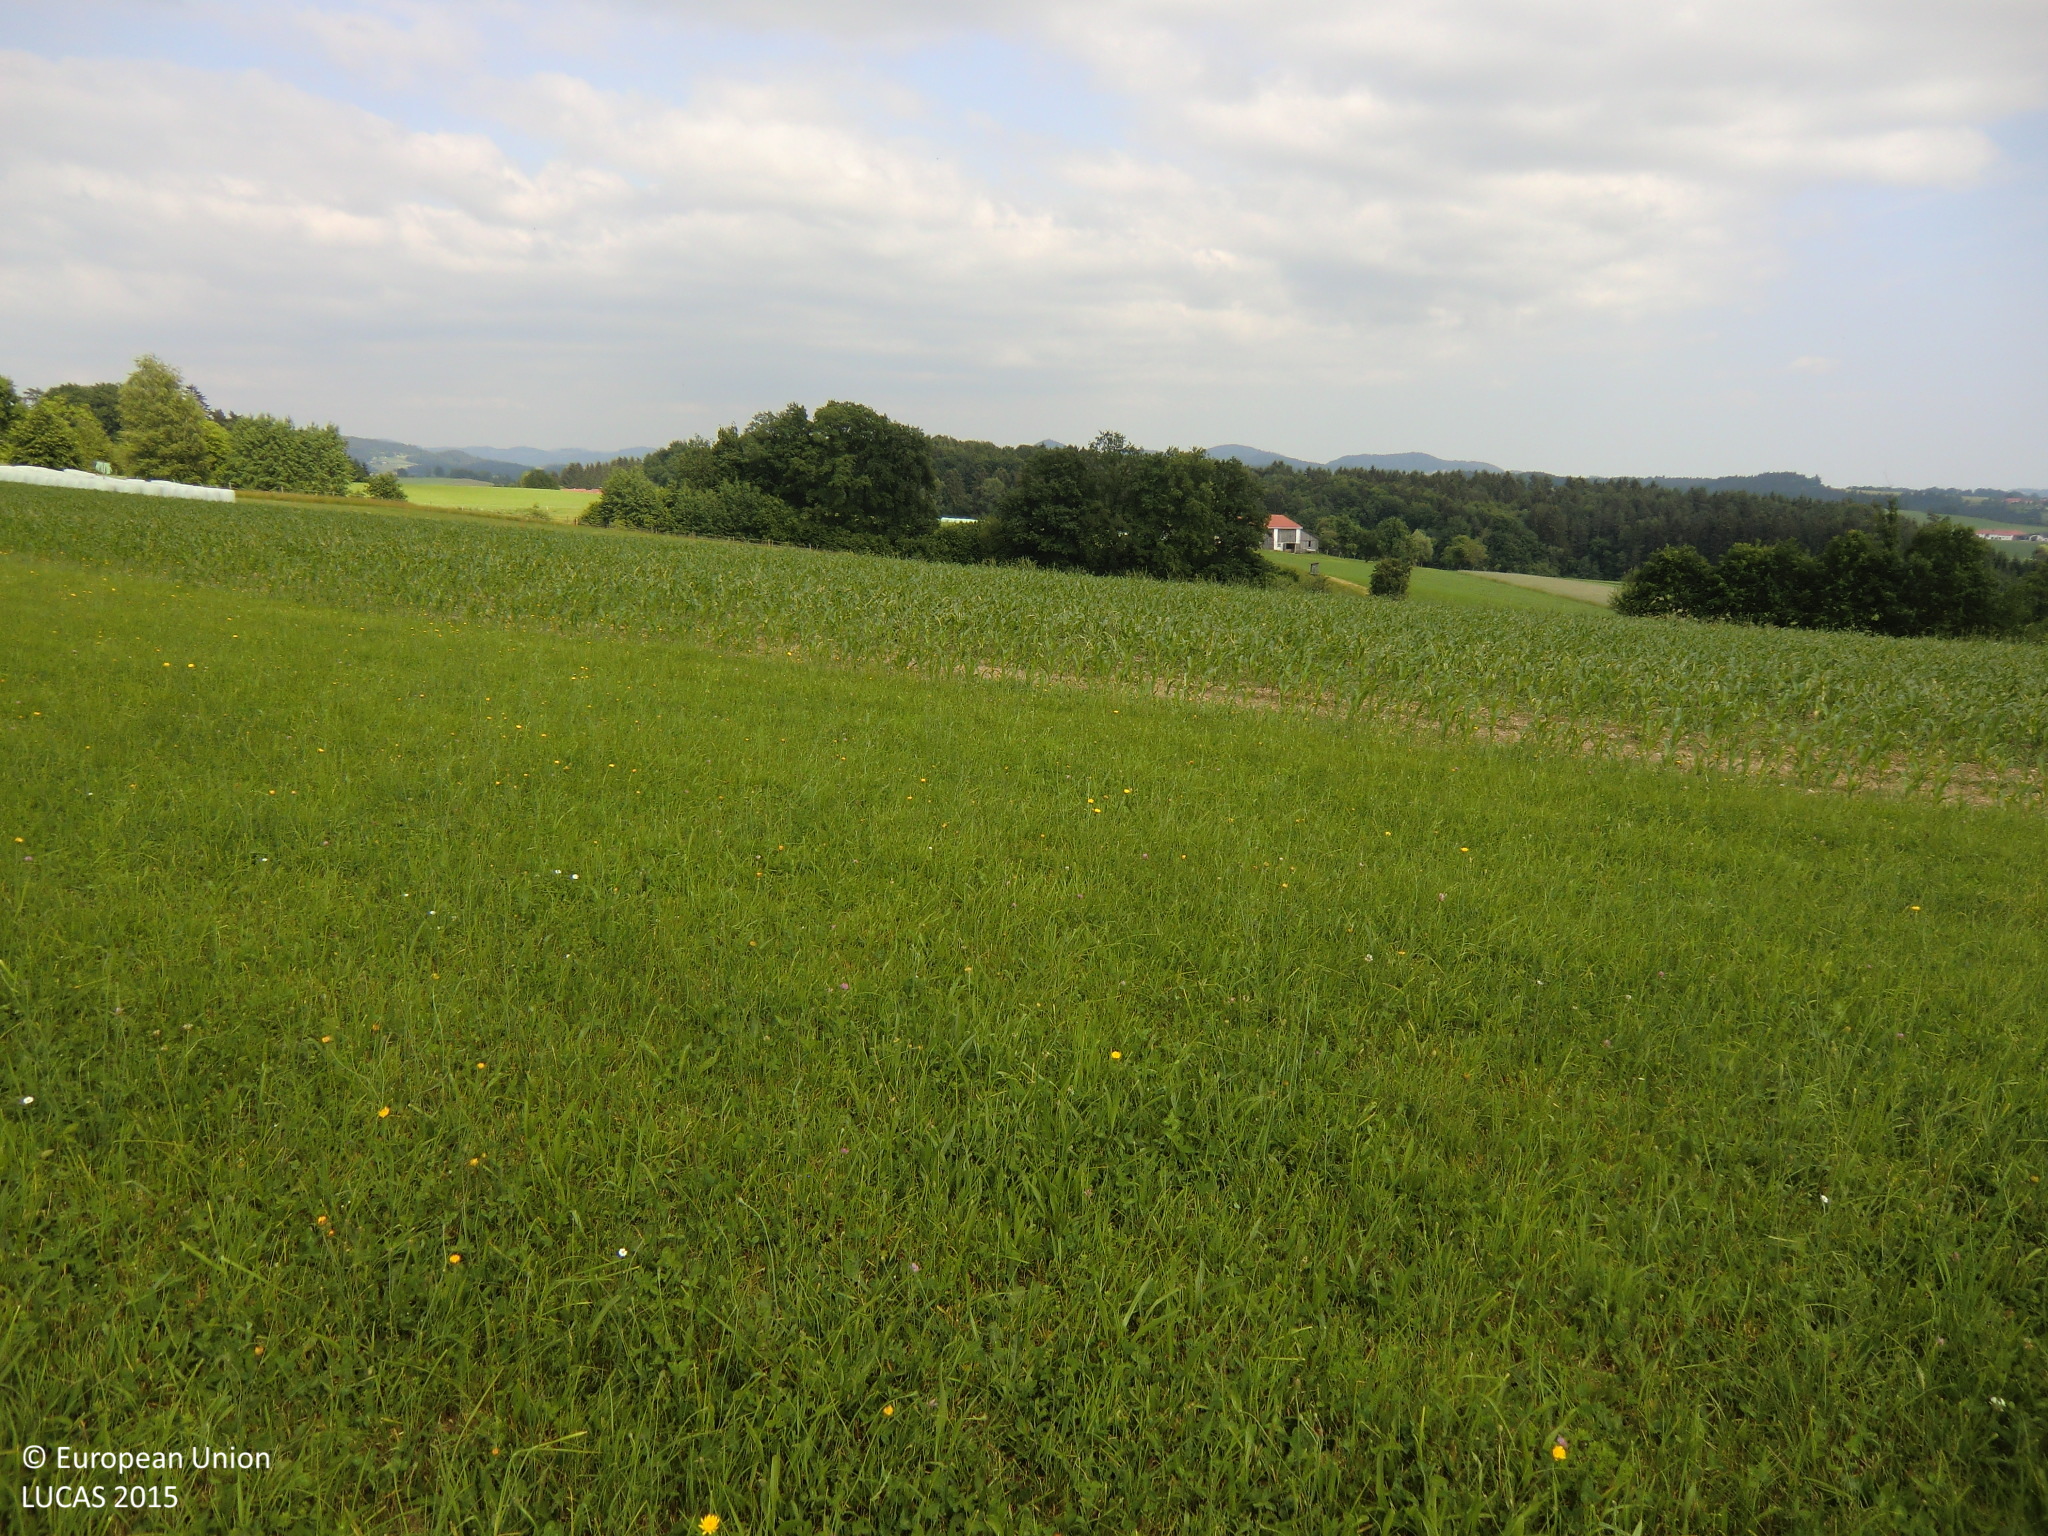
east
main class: Grassland
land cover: Grassland without tree/shrub cover
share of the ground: > 75 %
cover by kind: herbaceous plants 100 %
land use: Agriculture (excluding fallow land and kitchen gardens)
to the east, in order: Grassland without tree/shrub cover; Maize; Grassland without tree/shrub cover; Fences; Grassland without tree/shrub cover; Fences; Grassland without tree/shrub cover
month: June
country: AT
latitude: 48.3606
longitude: 14.6301
